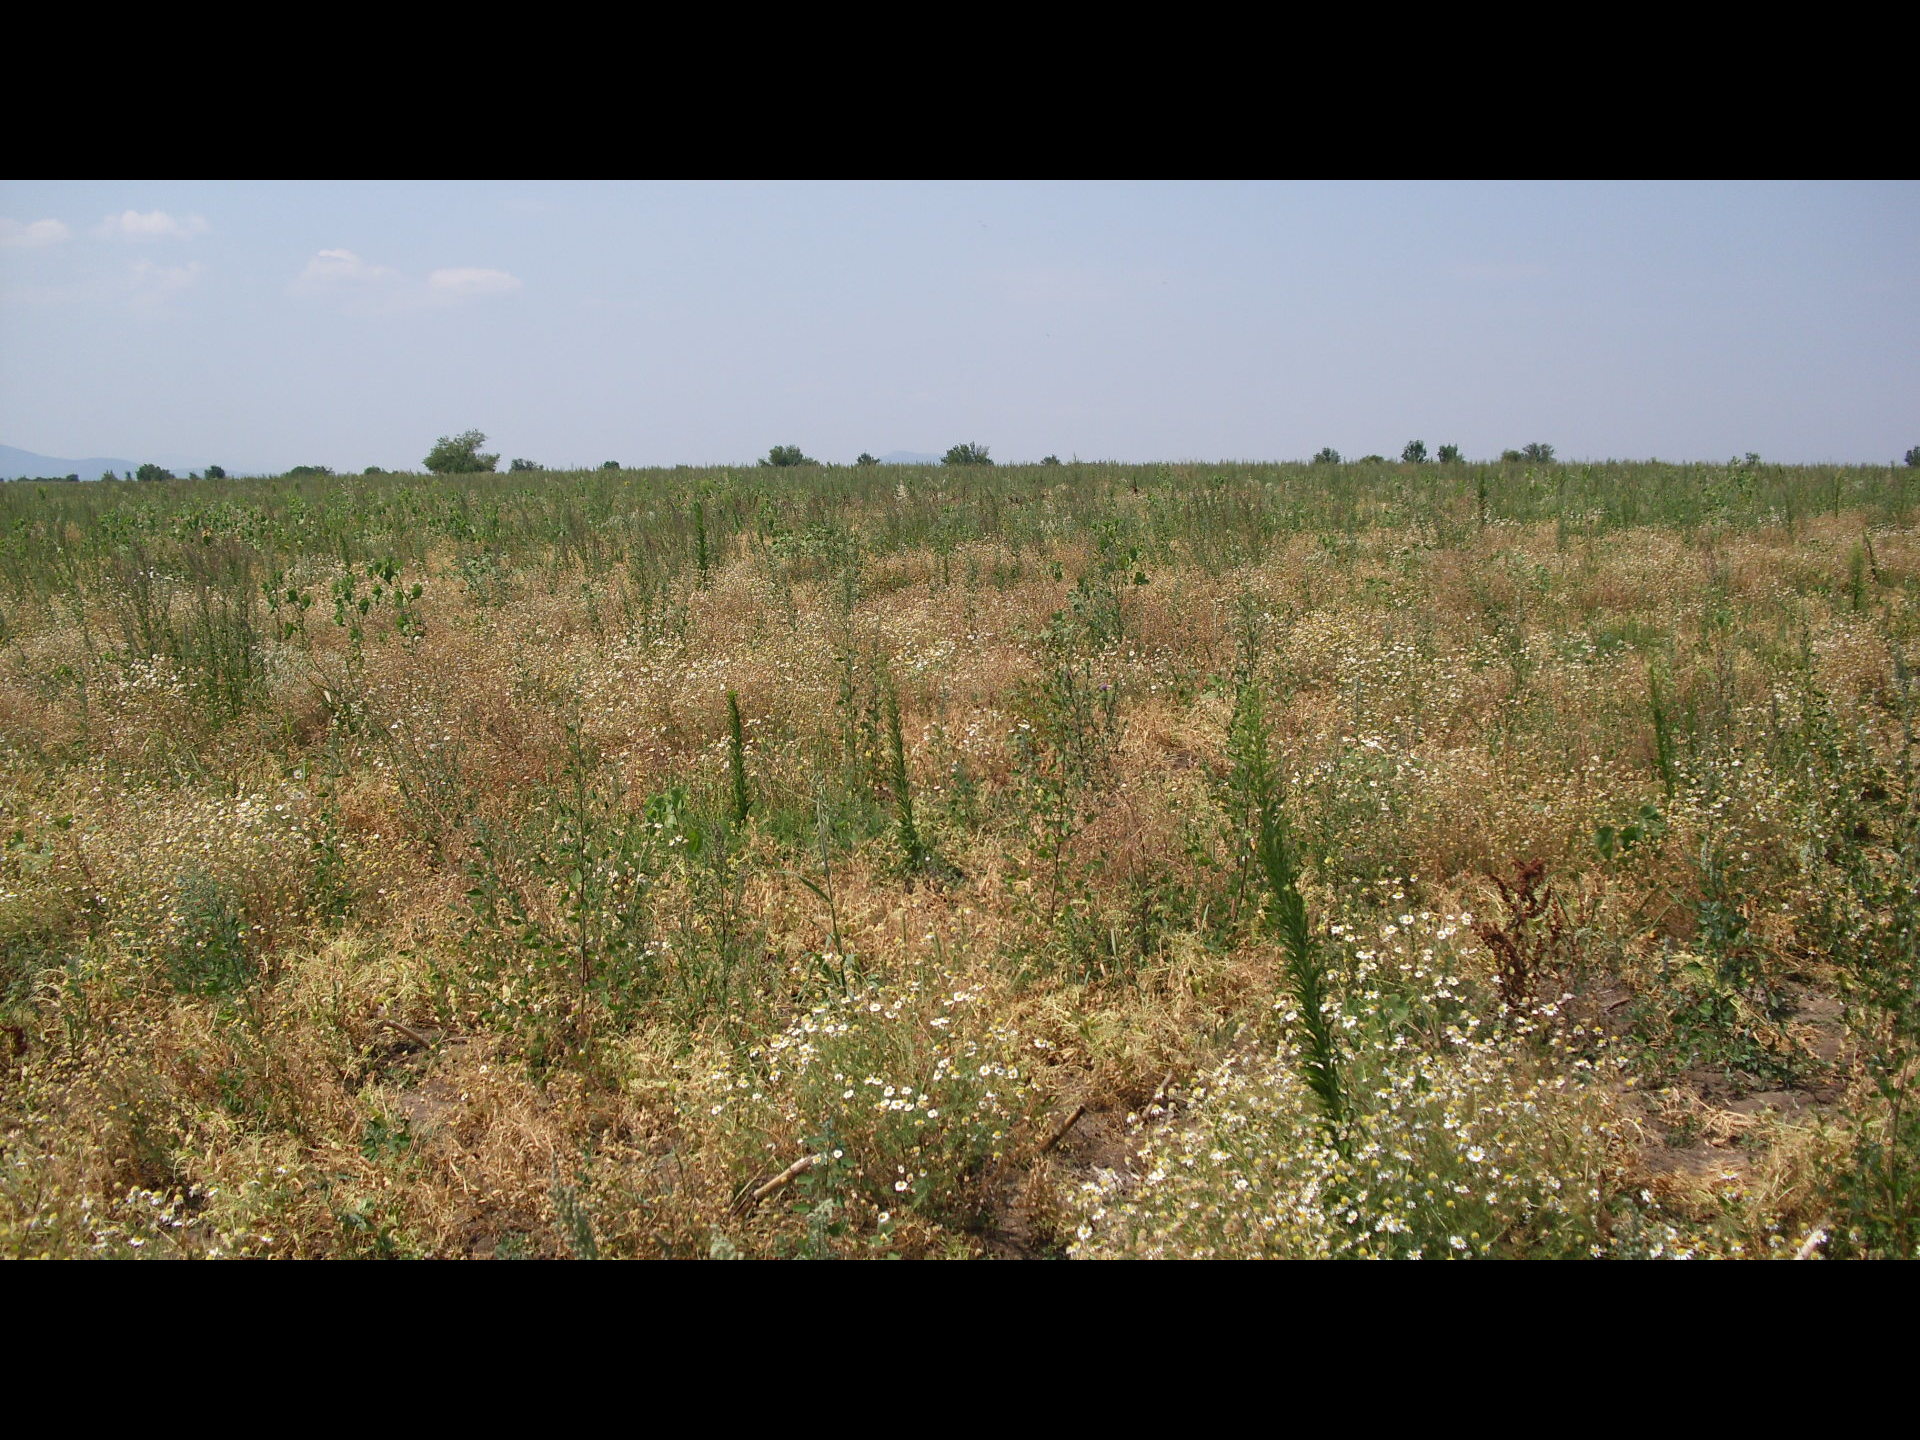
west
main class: Grassland
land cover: Spontaneously vegetated surfaces
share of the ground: > 75 %
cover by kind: herbaceous plants 100 %
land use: Fallow land
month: July
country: BG
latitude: 43.8158
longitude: 22.6036
